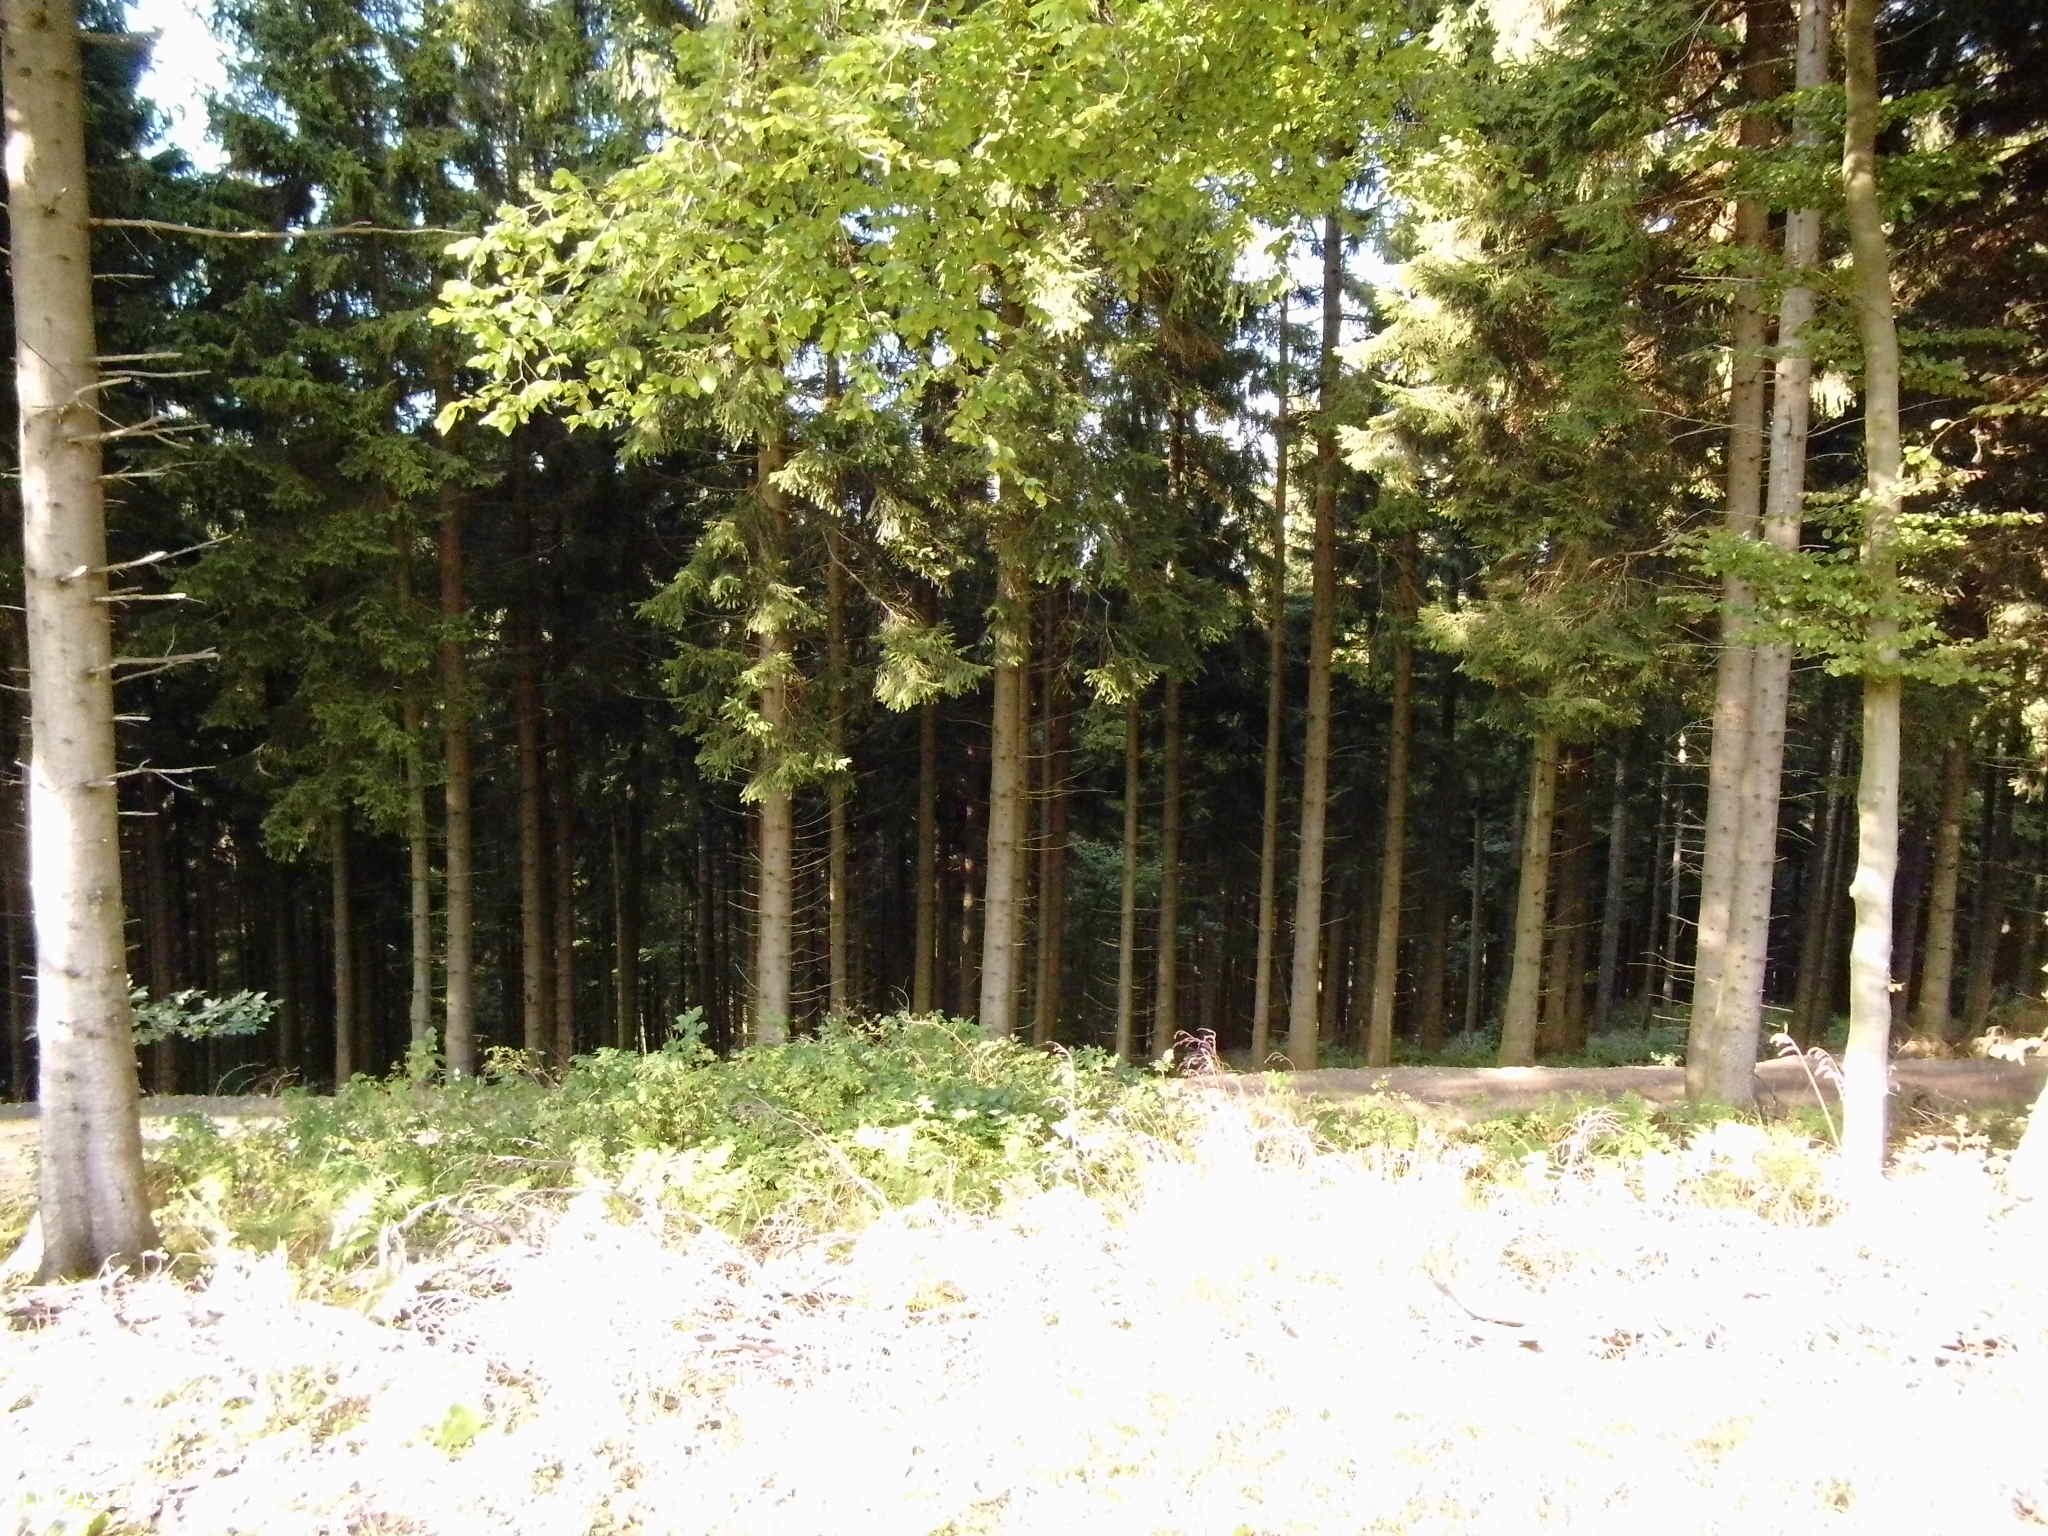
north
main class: Woodland
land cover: Spruce dominated mixed woodland
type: hemiboreal forest and nemoral coniferous forest and mixed broadleaved-coniferous forest
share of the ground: 25 - 50 %
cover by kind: shrubs 50 %, coniferous forest trees 35 %, broadleaved forest trees 15 %
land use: Forestry
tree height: < 5 m
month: September
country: DE
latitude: 51.3083
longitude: 8.5802
